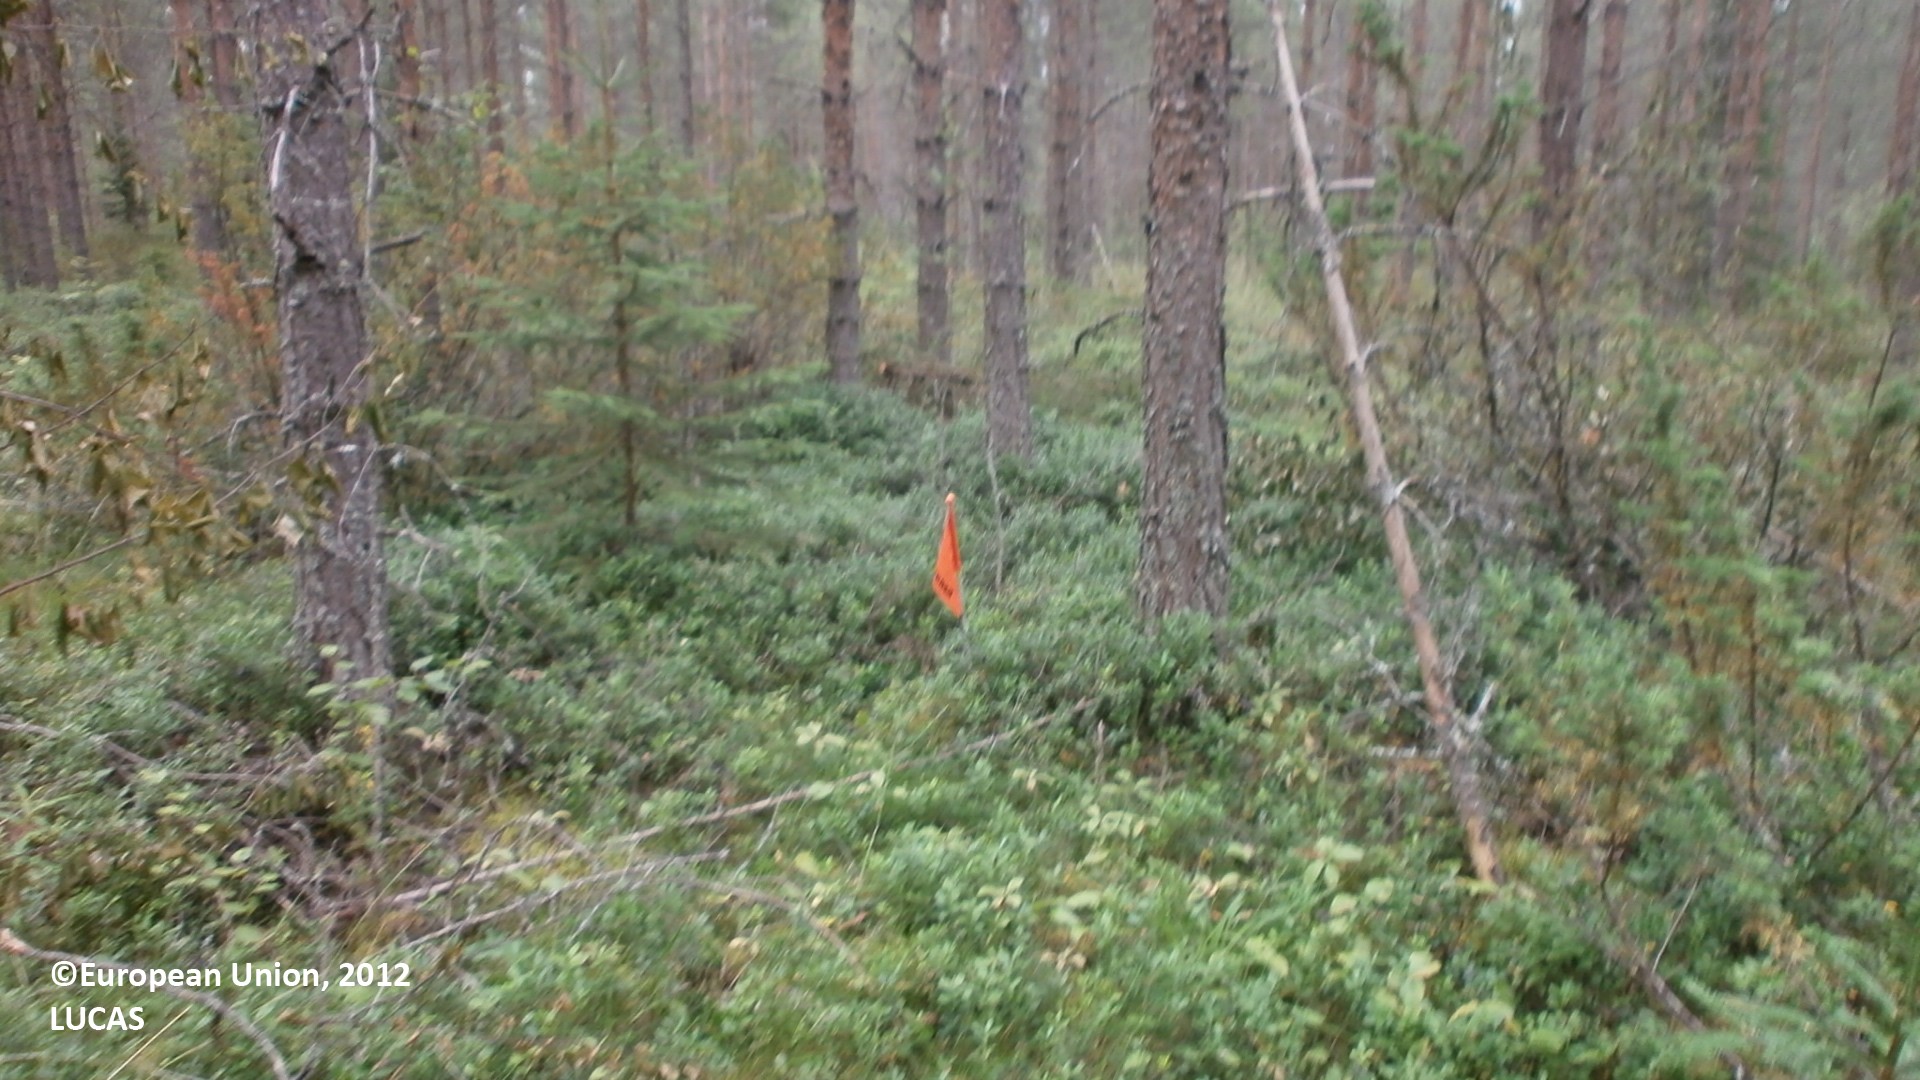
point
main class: Woodland
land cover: Pine dominated coniferous woodland
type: boreal forest
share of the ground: 50 - 75 %
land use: Forestry
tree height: > 5 m
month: July
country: FI
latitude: 64.0203
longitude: 23.9156
